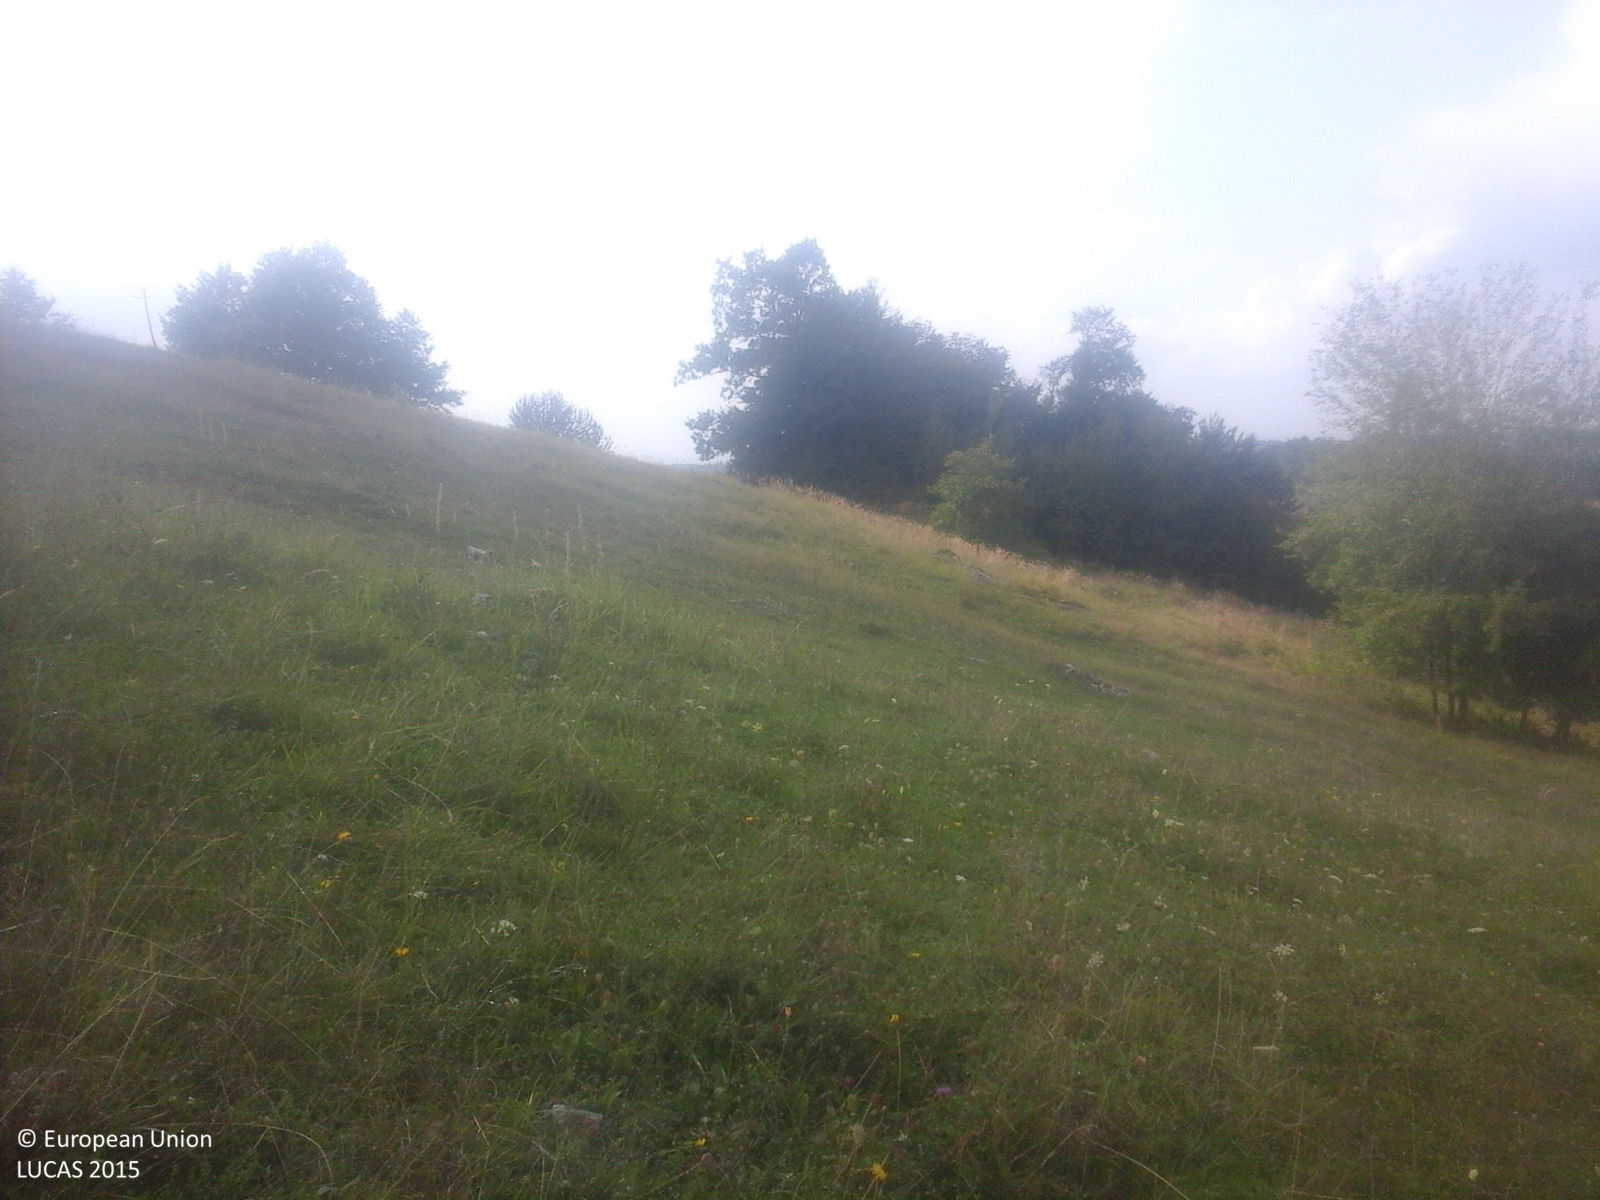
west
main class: Grassland
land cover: Grassland without tree/shrub cover
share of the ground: > 75 %
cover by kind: herbaceous plants 100 %
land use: Agriculture (excluding fallow land and kitchen gardens)
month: September
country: RO
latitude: 46.8476
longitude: 22.3921
